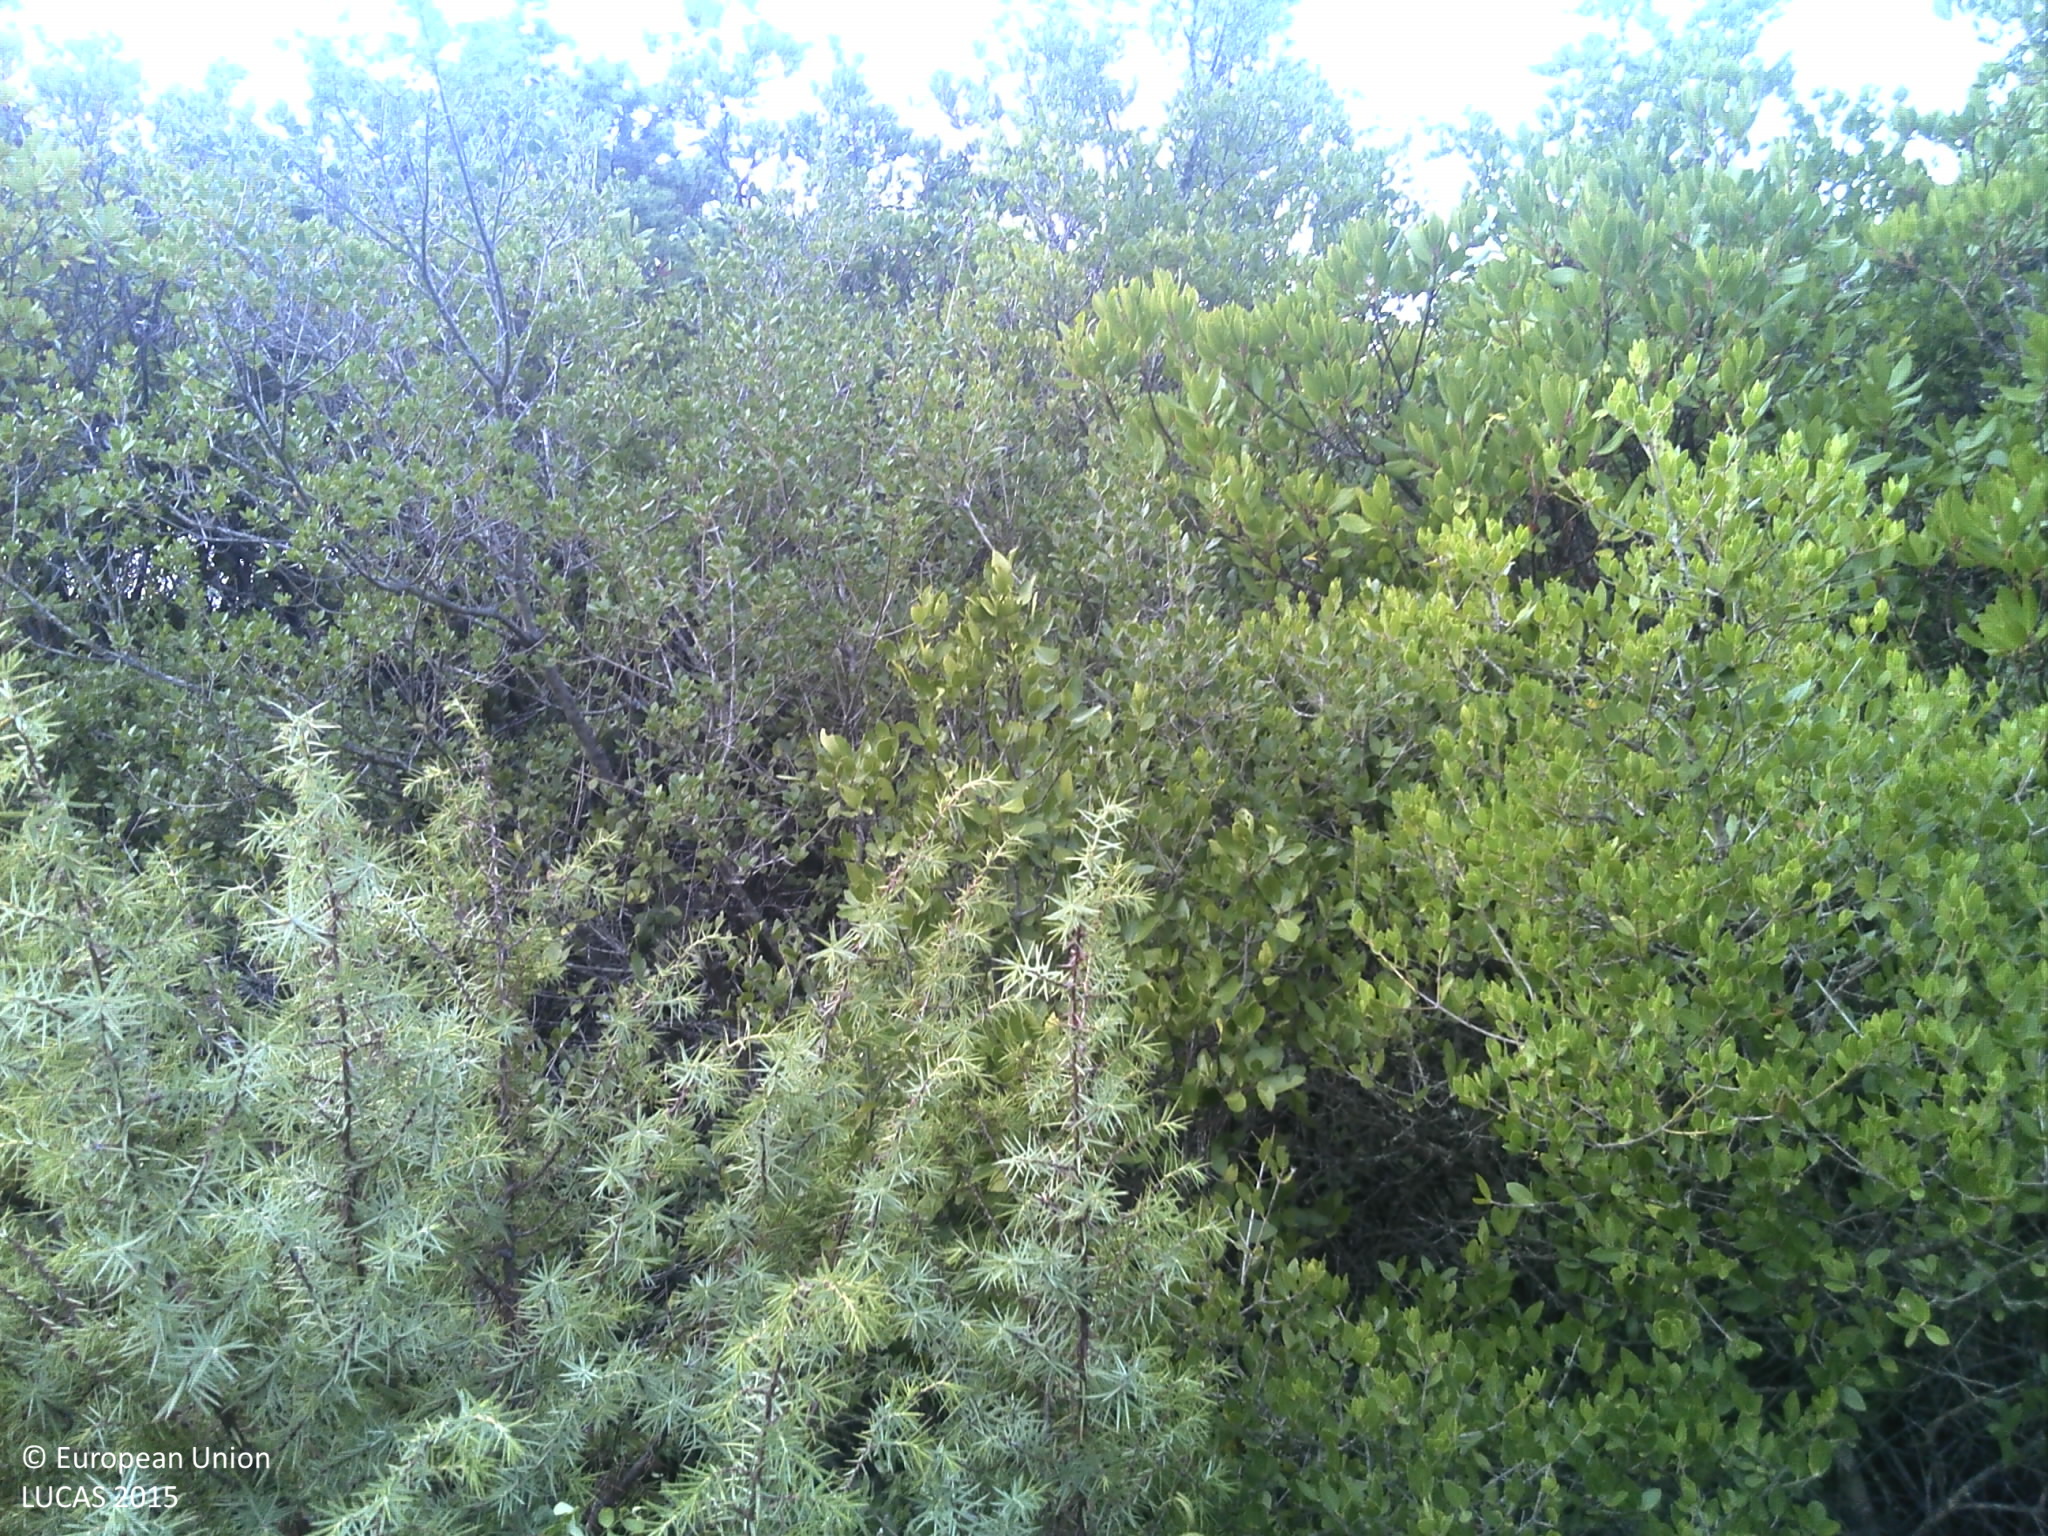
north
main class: Shrubland
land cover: Shrubland with sparse tree cover
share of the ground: > 75 %
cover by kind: shrubs 90 %, coniferous forest trees 5 %, consolidated bare surface 5 %
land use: Semi-natural and natural areas not in use
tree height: < 5 m
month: September
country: HR
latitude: 43.9919
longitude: 15.0665
